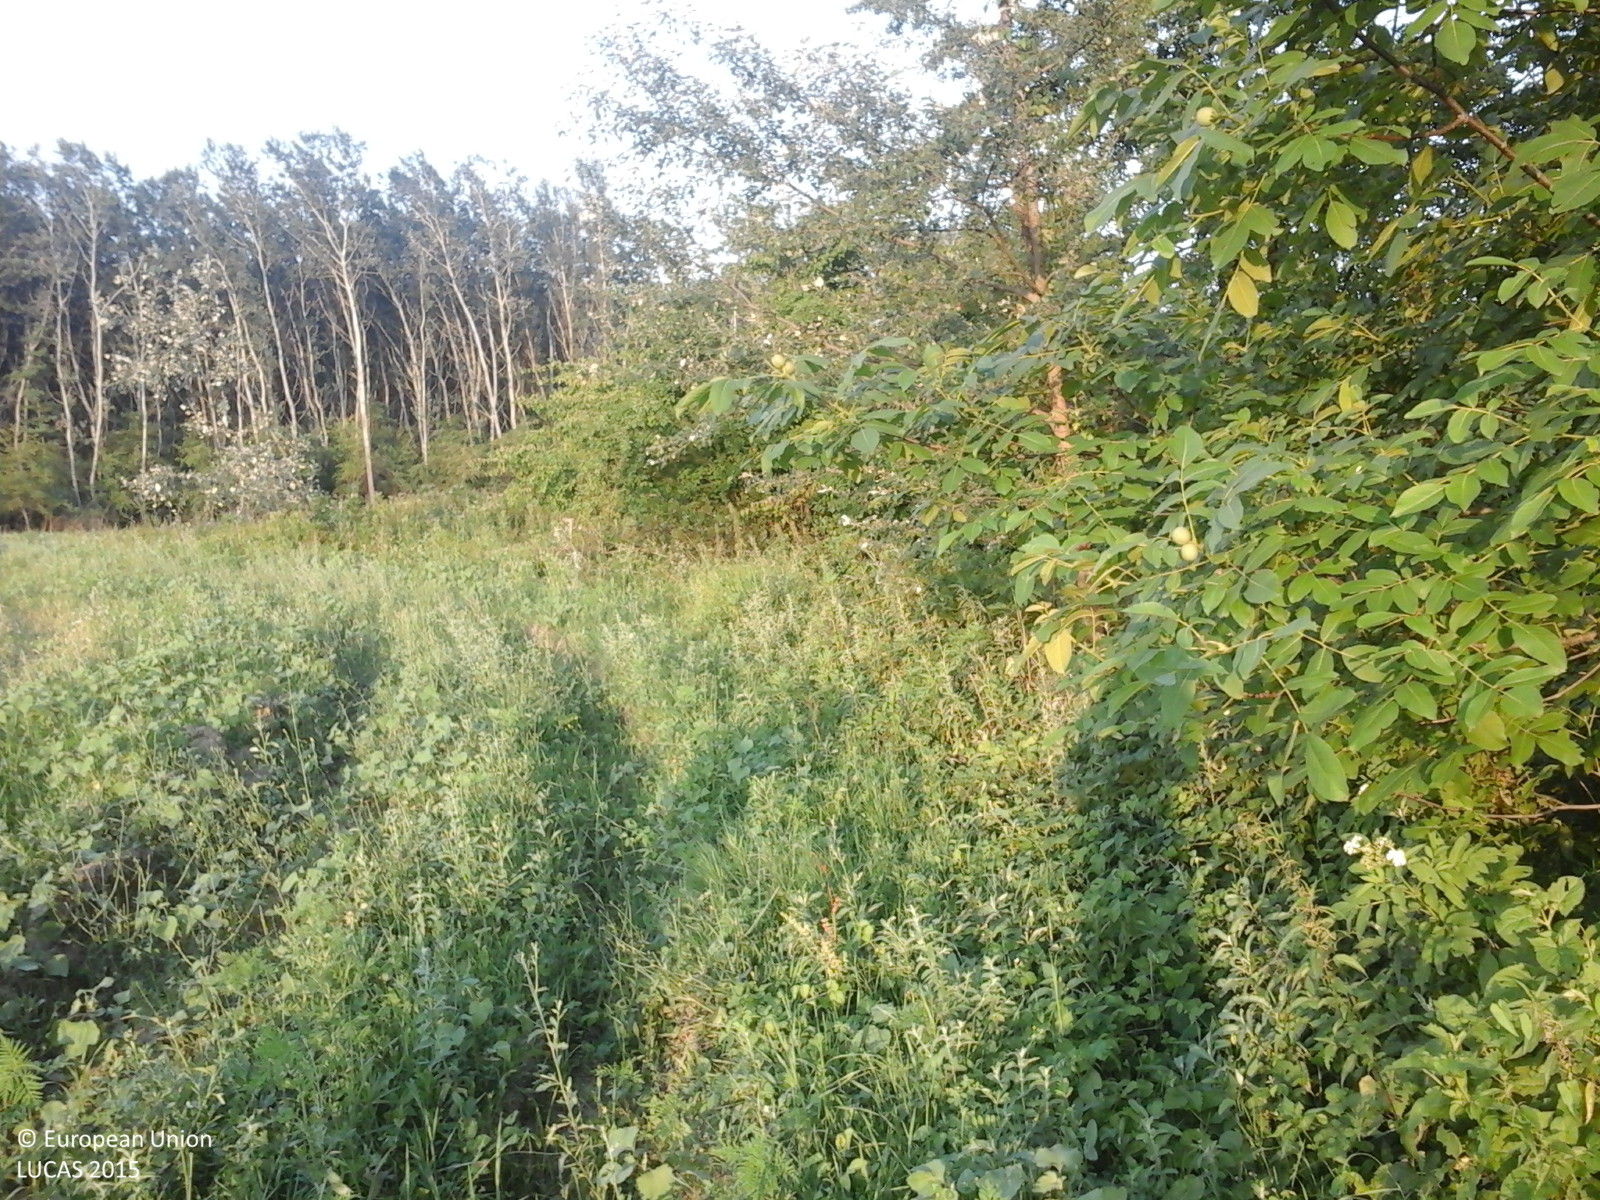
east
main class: Woodland
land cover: Broadleaved woodland
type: non-riverine alder, birch or aspen forest
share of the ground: > 75 %
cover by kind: broadleaved forest trees 100 %
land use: Forestry
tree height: > 5 m
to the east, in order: Broadleaved woodland; Tracks; Broadleaved woodland
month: July
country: RO
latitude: 44.7017
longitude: 25.6068
